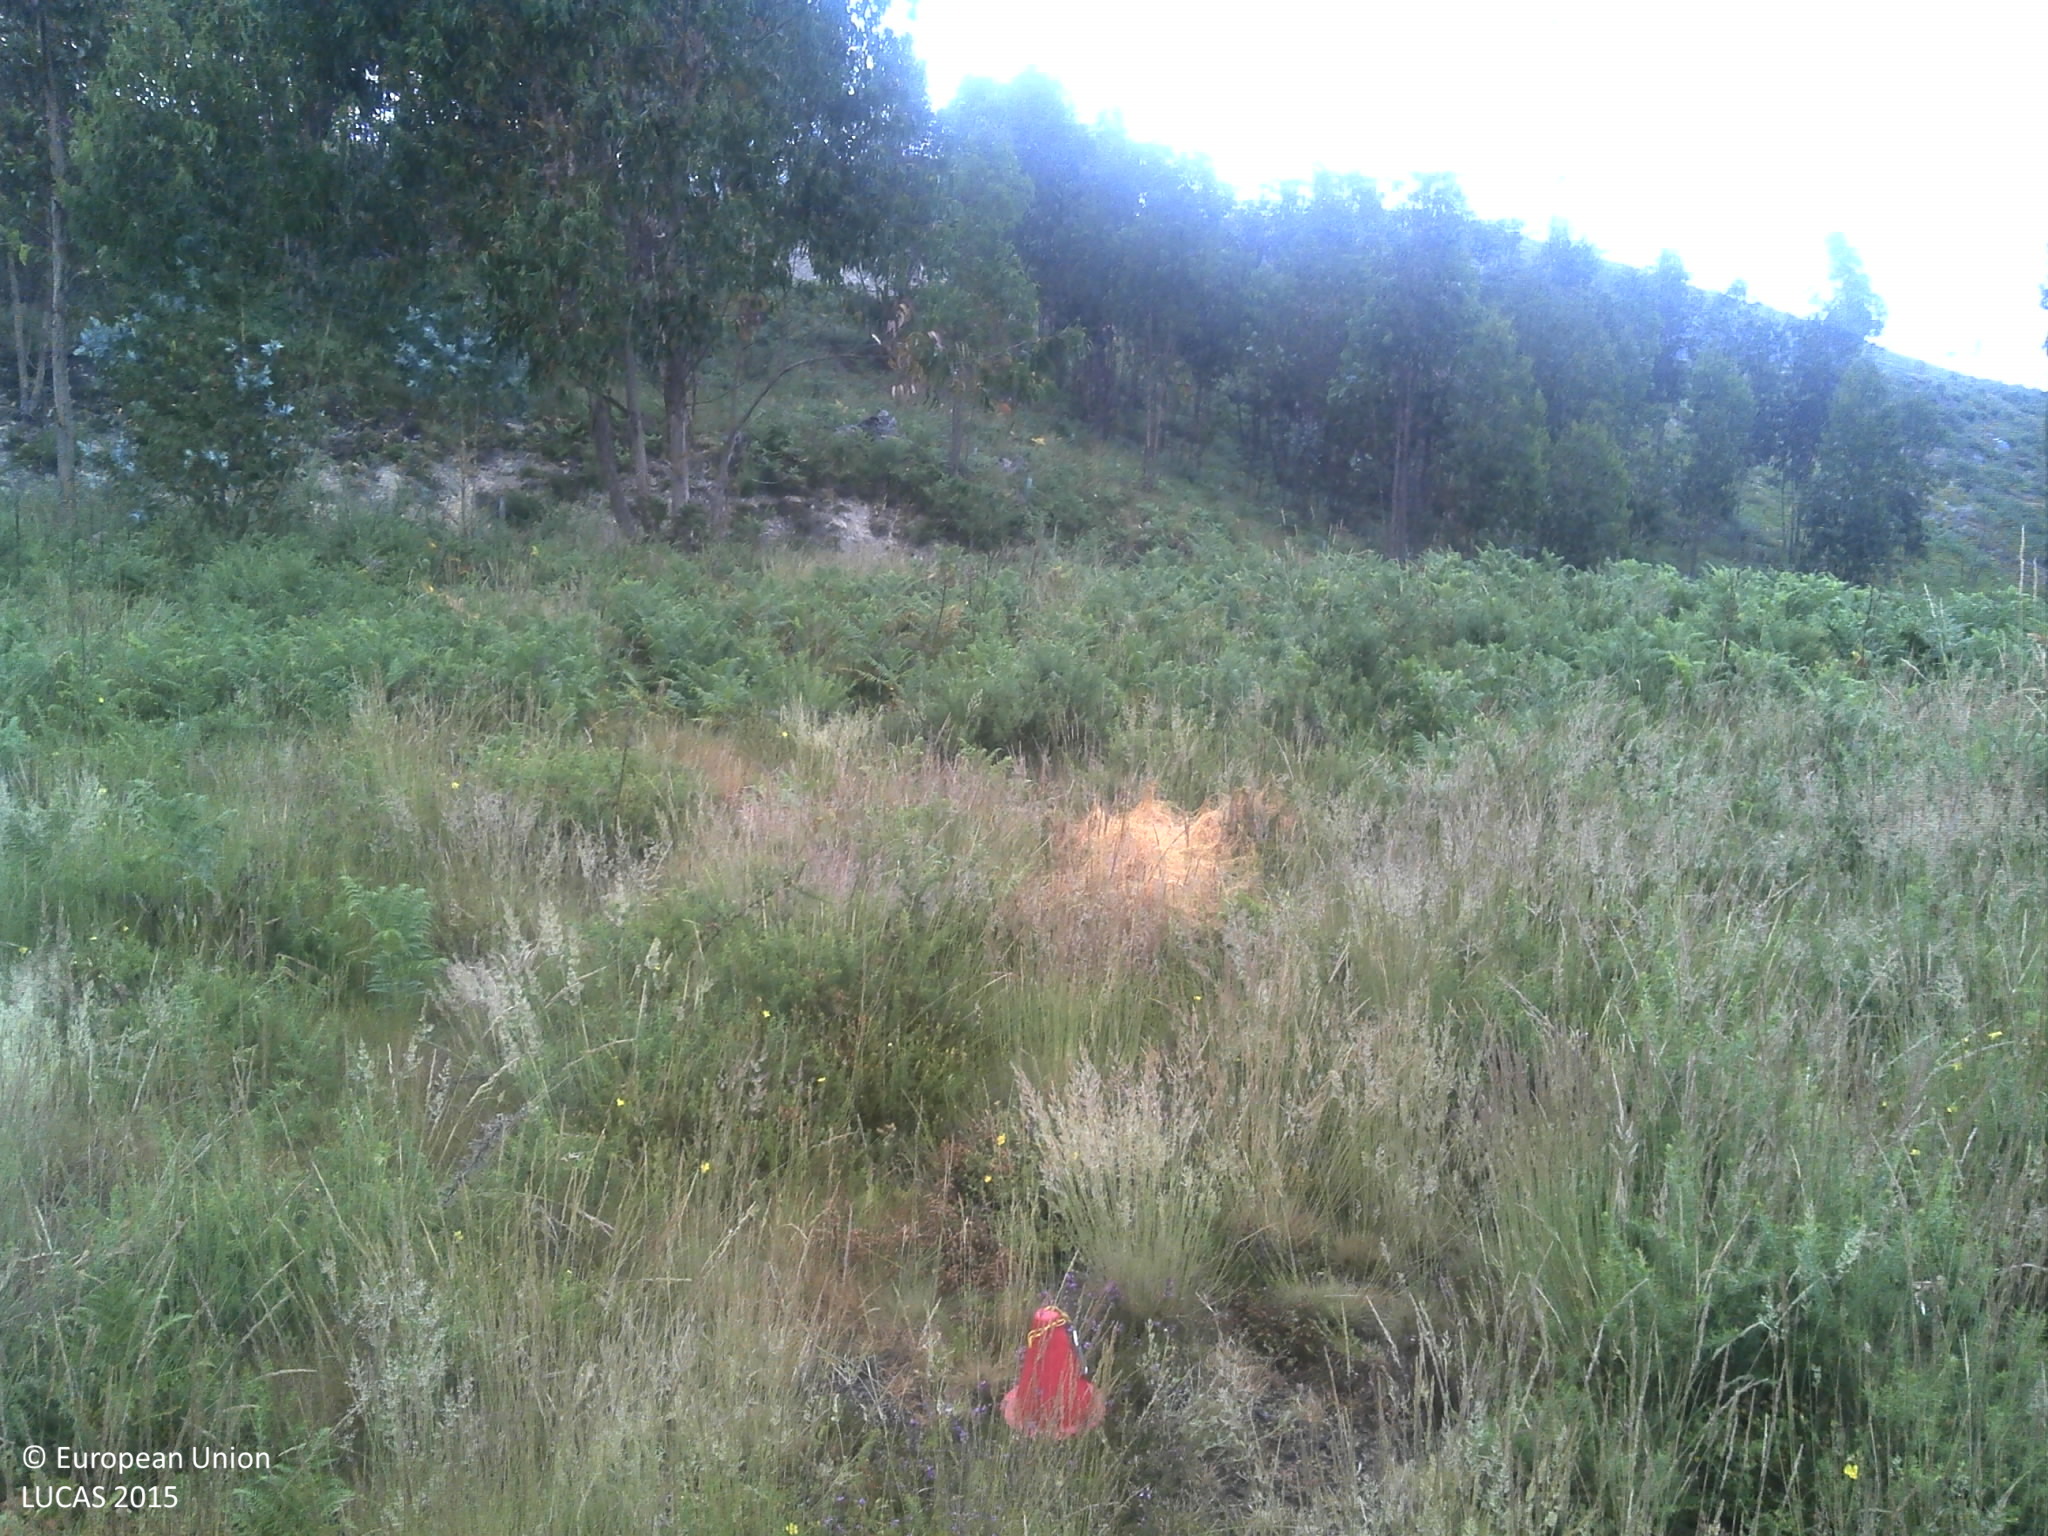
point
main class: Shrubland
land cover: Shrubland without tree cover
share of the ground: > 75 %
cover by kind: shrubs 55 %, herbaceous plants 40 %, unconsolidated bare surface 5 %
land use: Agriculture (excluding fallow land and kitchen gardens)
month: June
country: PT
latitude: 41.5755
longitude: -8.3212
